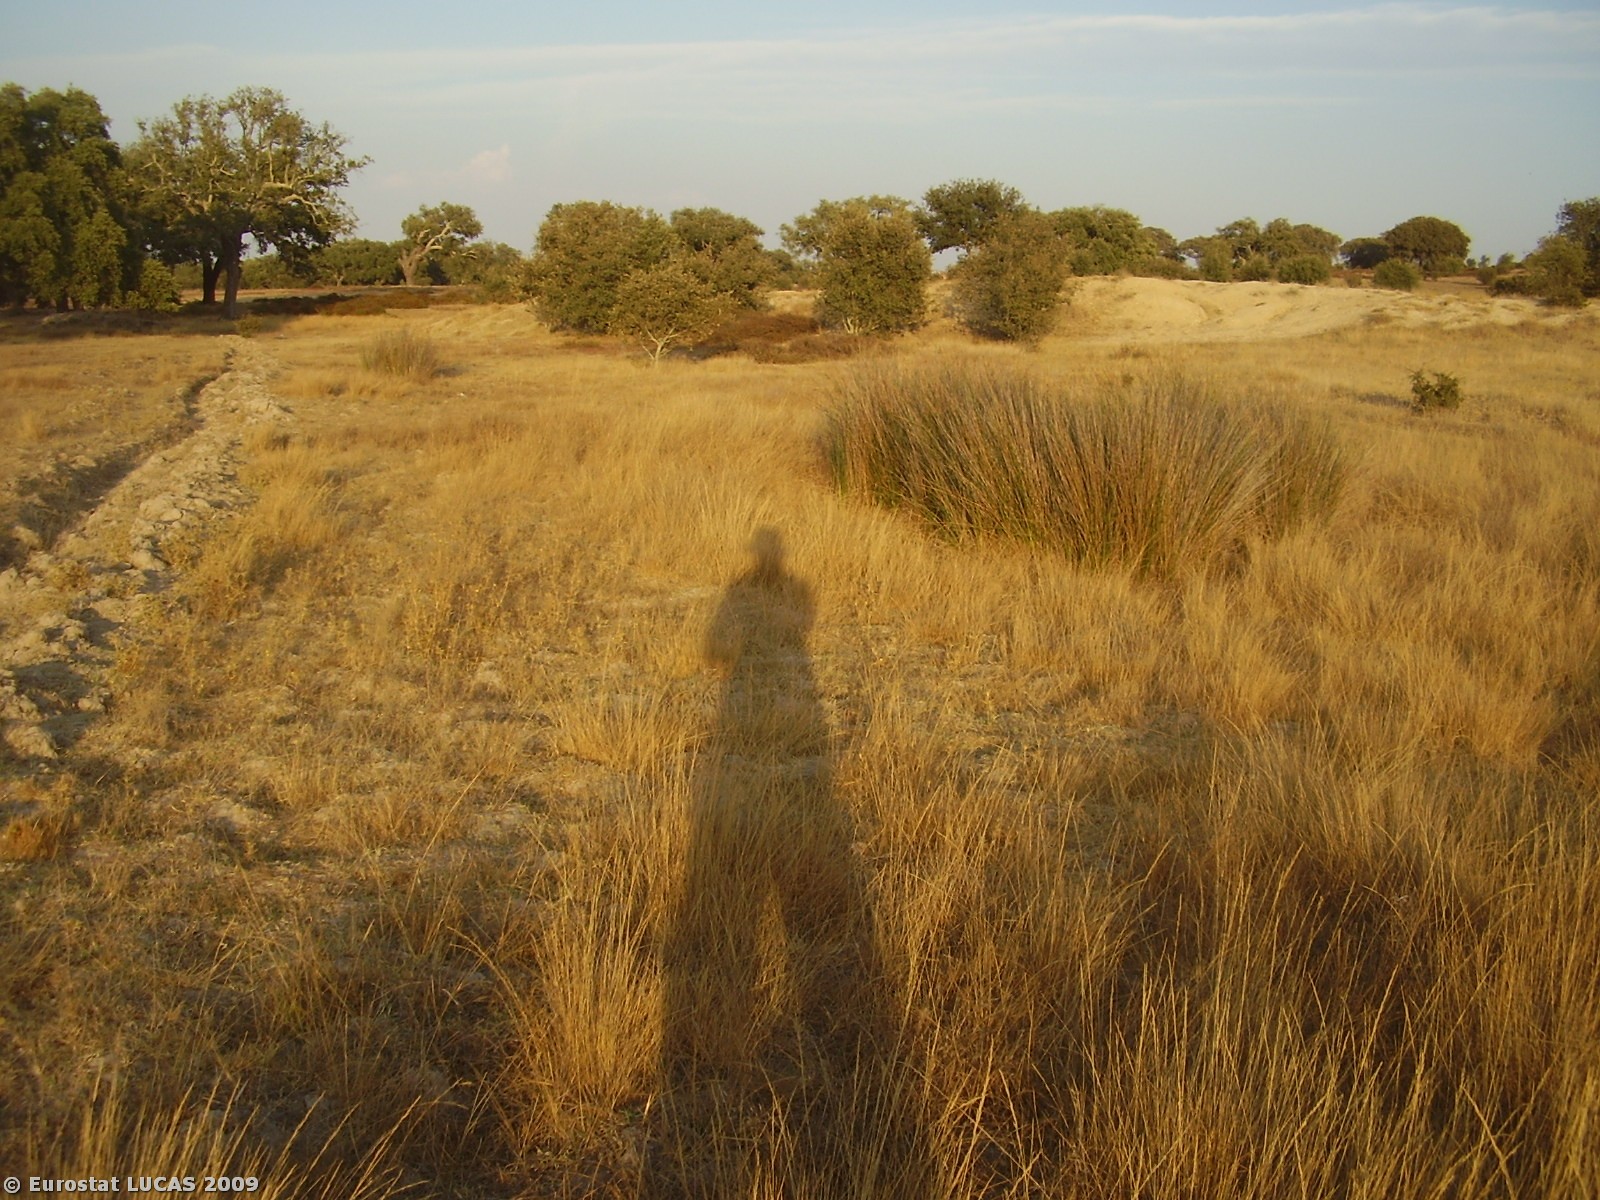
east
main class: Grassland
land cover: Grassland without tree/shrub cover
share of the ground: > 75 %
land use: Fallow land
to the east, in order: Grassland without tree/shrub cover; Broadleaved woodland; Grassland without tree/shrub cover; Broadleaved woodland
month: August
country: PT
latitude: 37.9115
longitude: -8.4316
